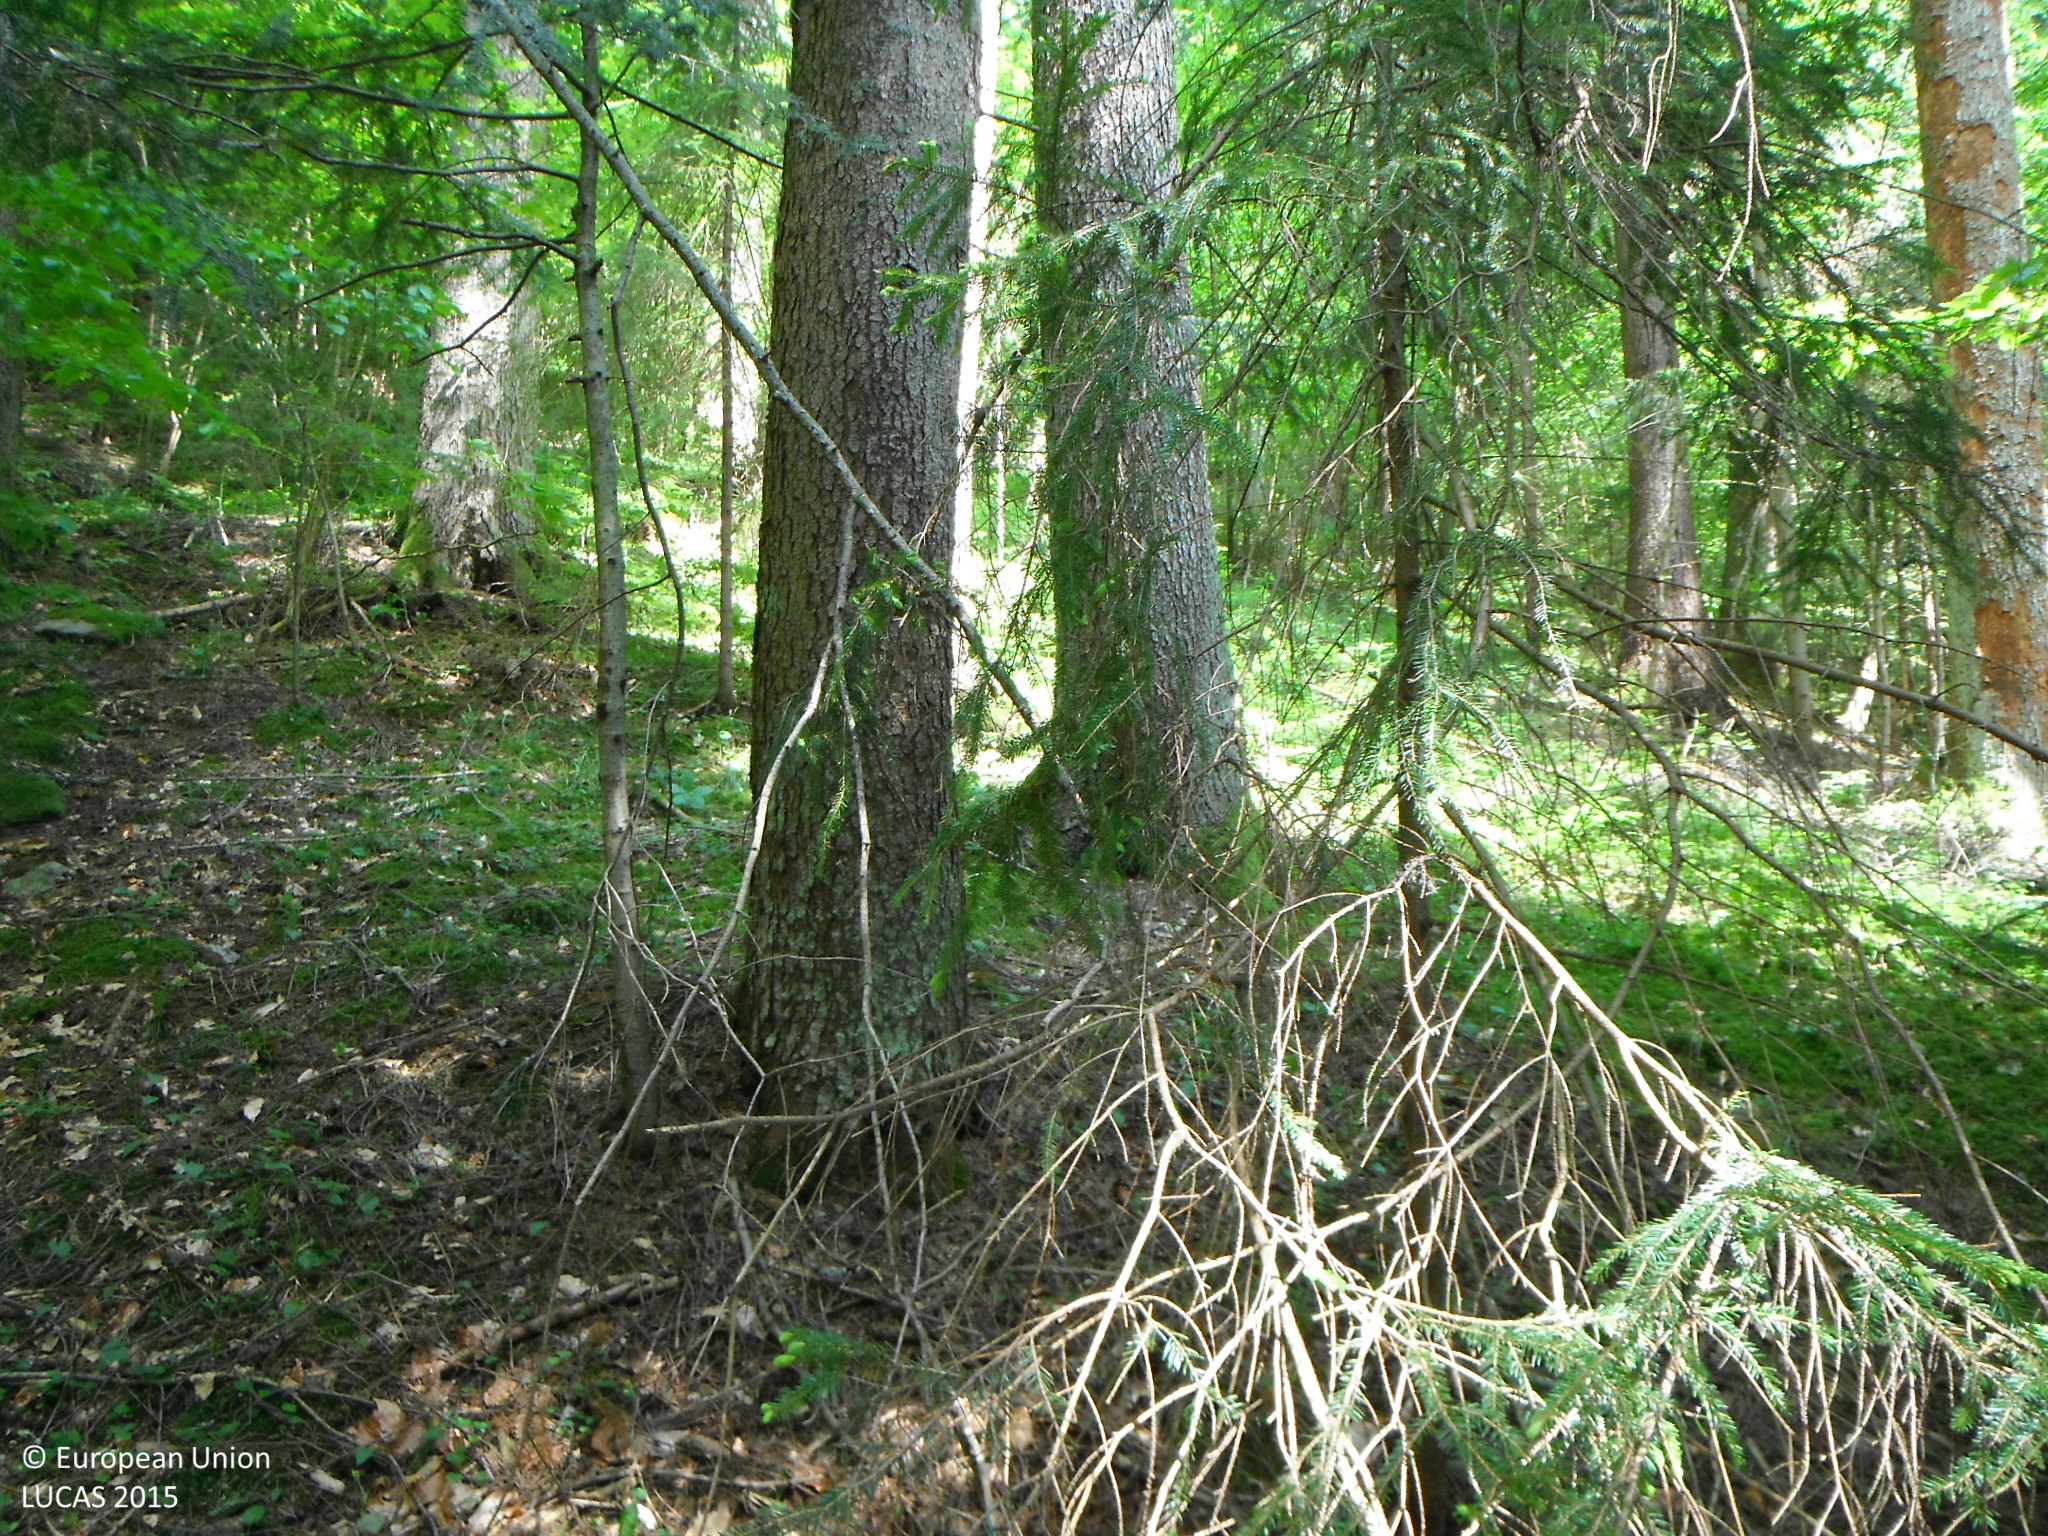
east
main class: Woodland
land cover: Spruce dominated coniferous woodland
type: alpine coniferous forest
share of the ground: > 75 %
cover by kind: coniferous forest trees 90 %, broadleaved forest trees 10 %
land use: Forestry
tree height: > 5 m
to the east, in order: Spruce dominated coniferous woodland; Tracks; Spruce dominated coniferous woodland; Tracks; Spruce dominated coniferous woodland; Spruce dominated mixed woodland; Spruce dominated coniferous woodland; Tracks; Spruce dominated coniferous woodland; Spruce dominated mixed woodland
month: June
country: SK
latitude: 48.7826
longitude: 19.5939
